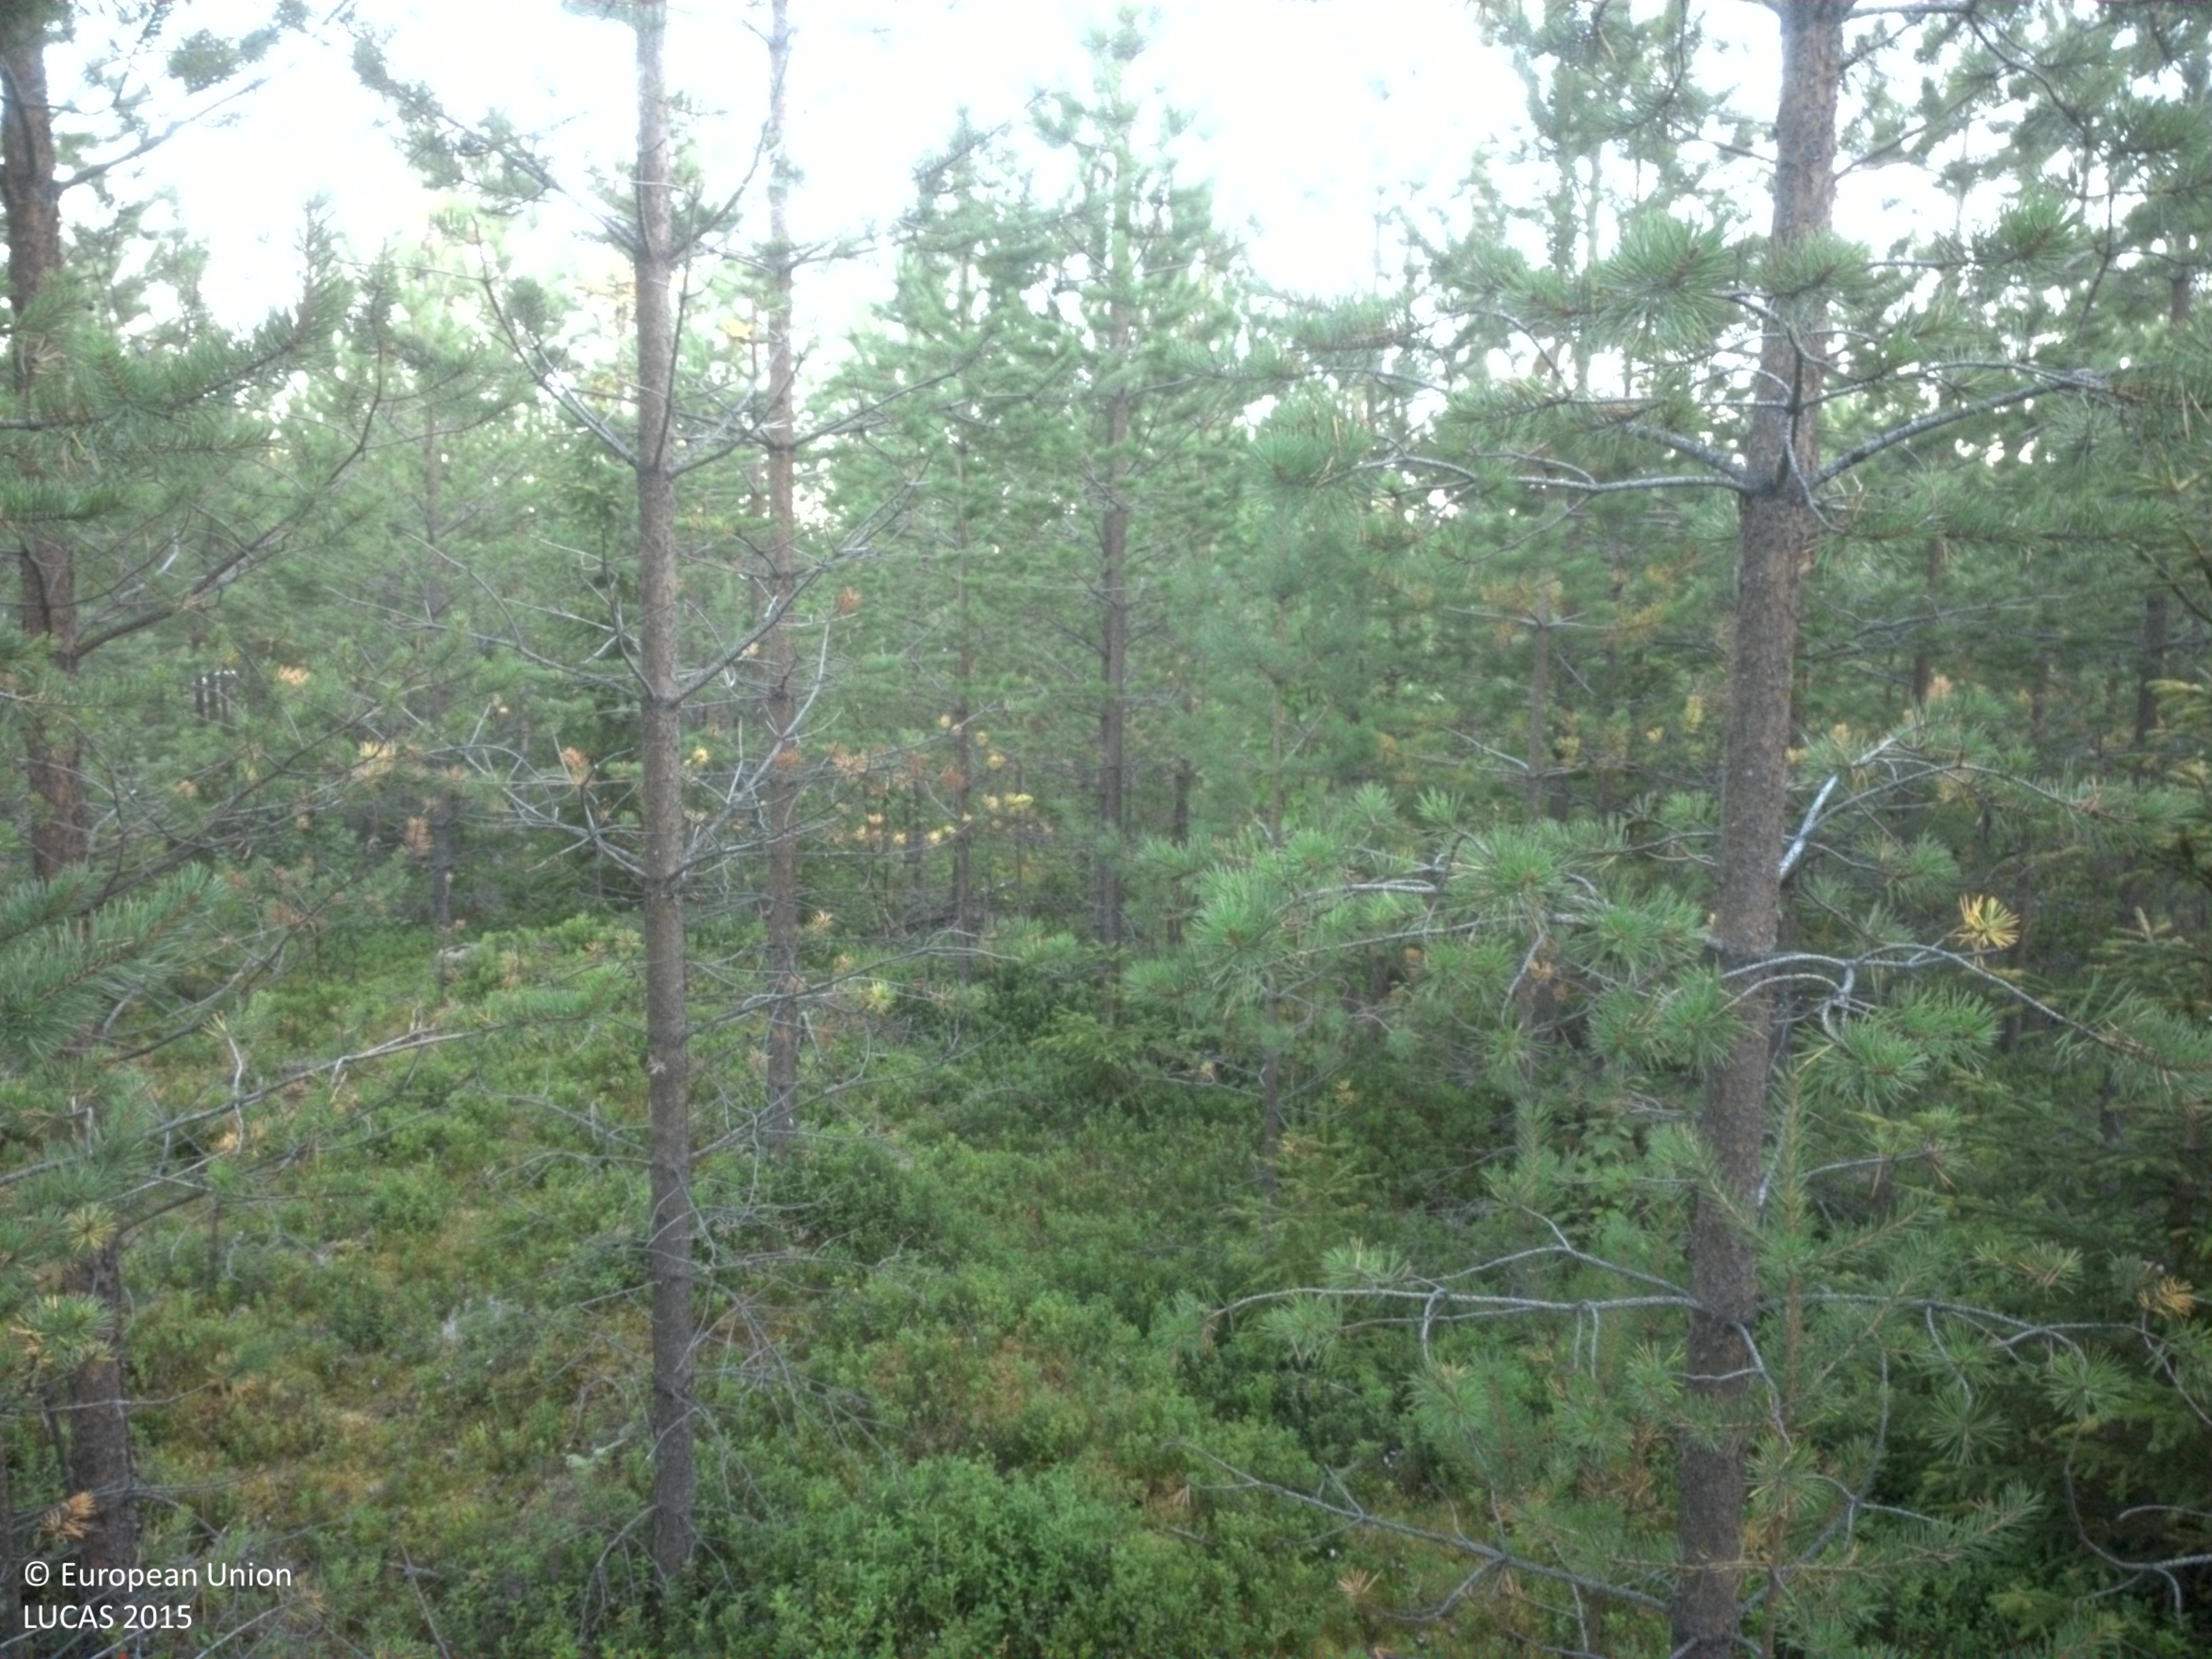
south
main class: Woodland
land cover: Pine dominated coniferous woodland
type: boreal forest
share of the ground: 50 - 75 %
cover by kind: coniferous forest trees 70 %, shrubs 30 %
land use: Forestry
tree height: < 5 m
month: August
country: SE
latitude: 64.6391
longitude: 18.9032
